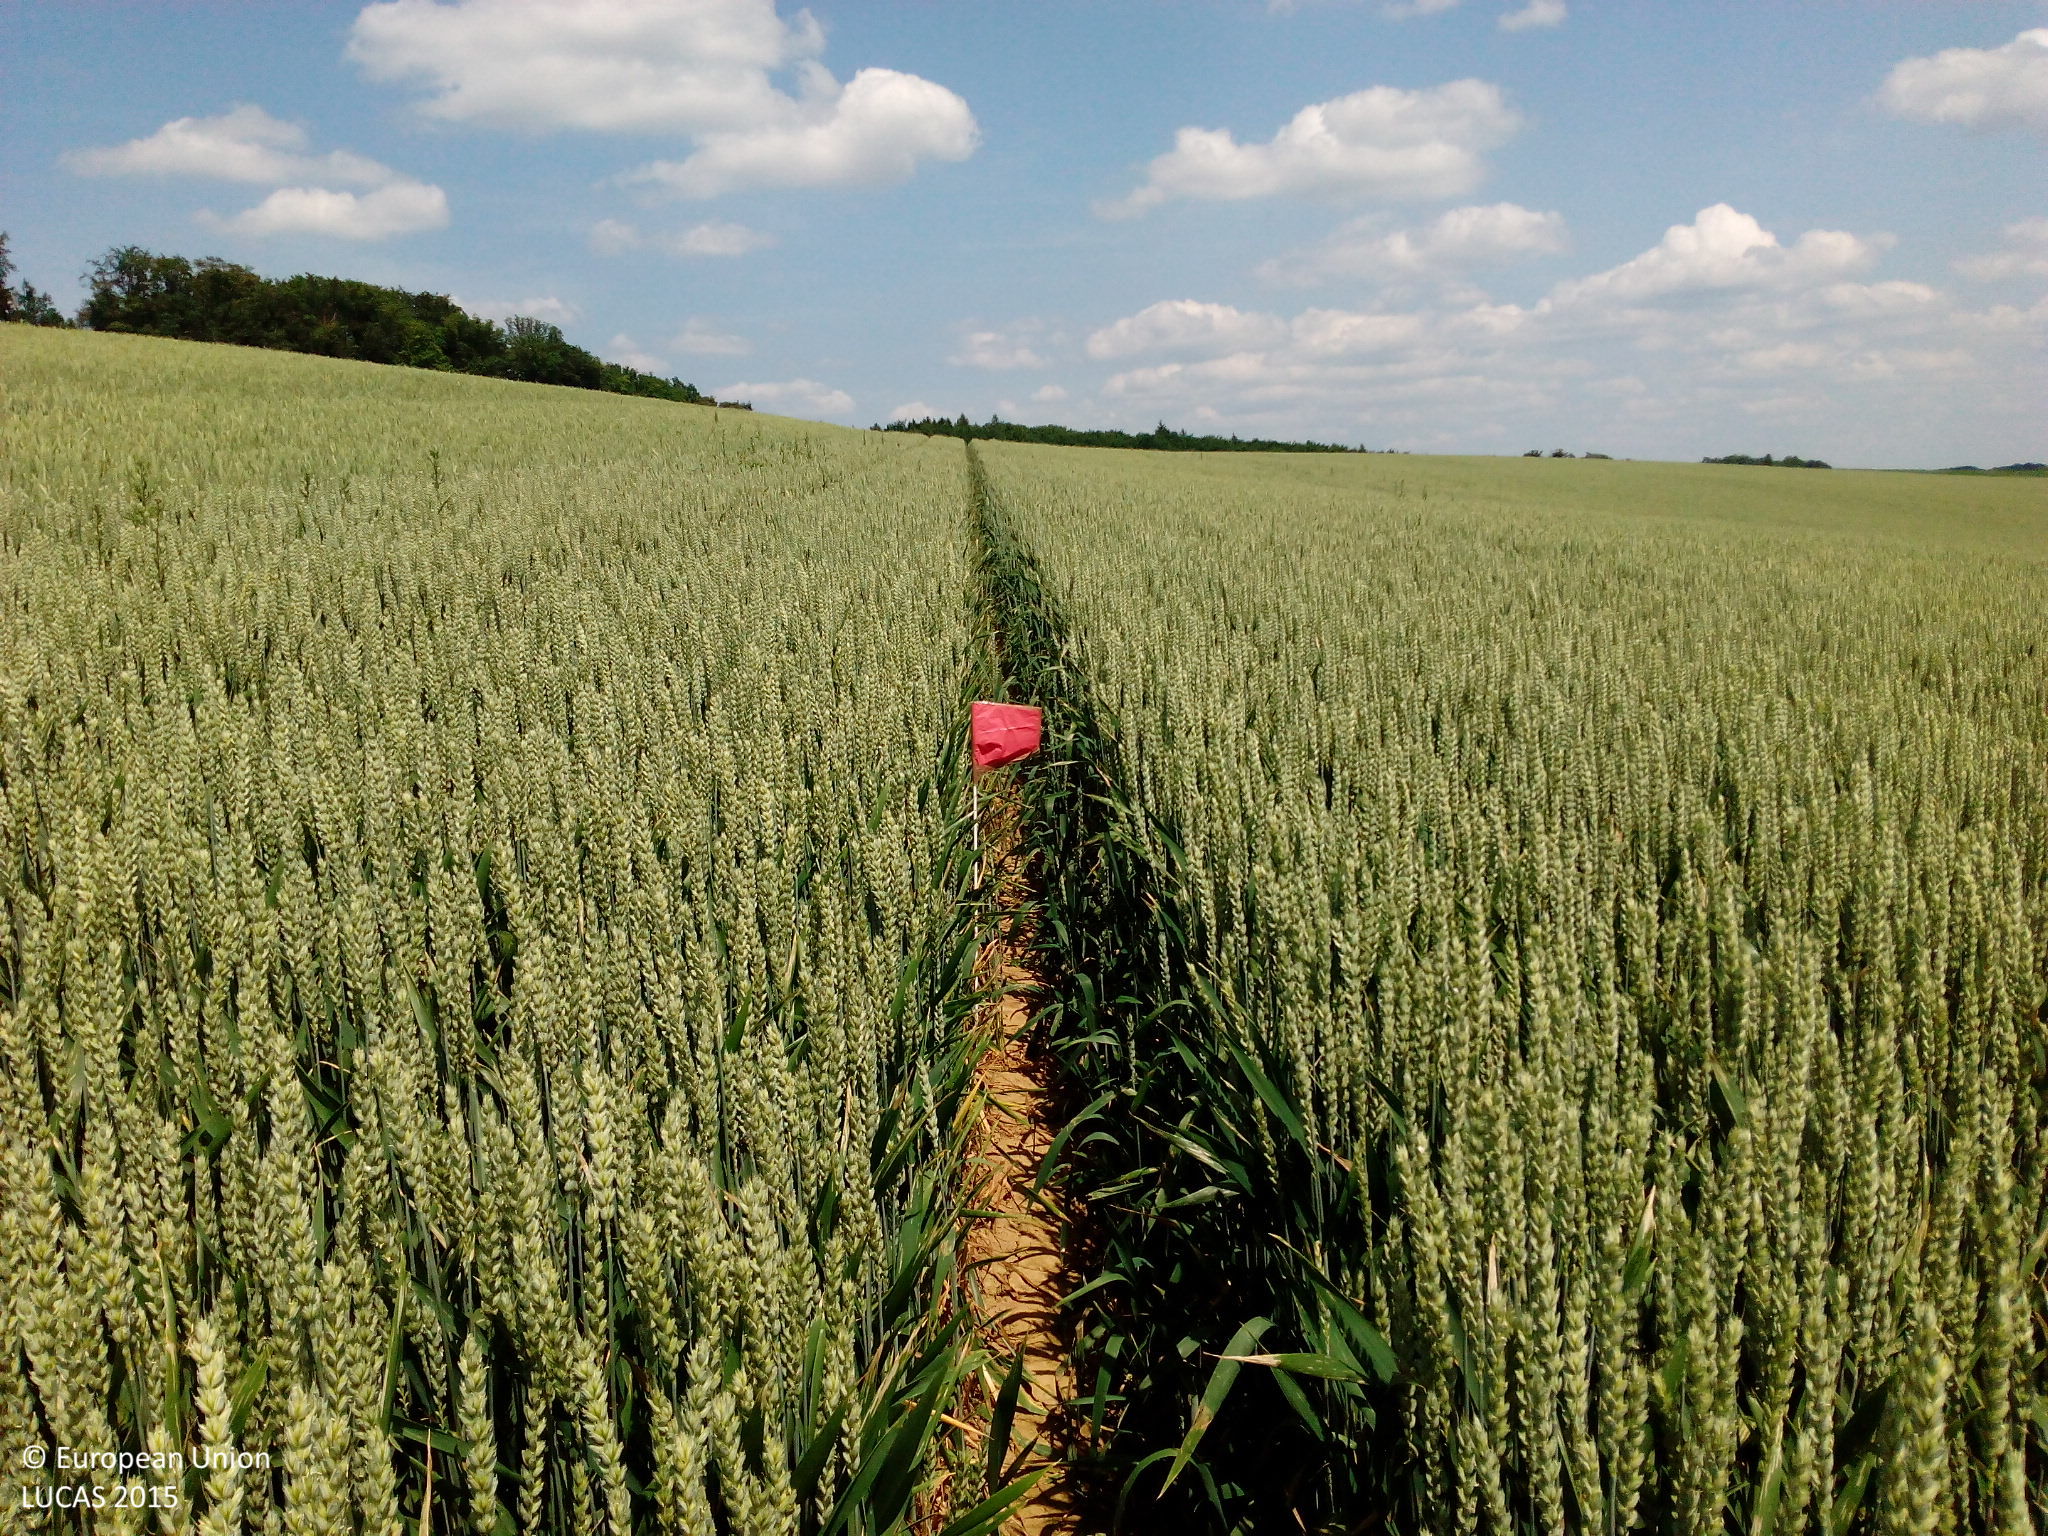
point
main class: Cropland
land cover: Common wheat
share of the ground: > 75 %
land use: Agriculture (excluding fallow land and kitchen gardens)
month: June
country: DE
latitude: 49.3022
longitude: 9.5738
